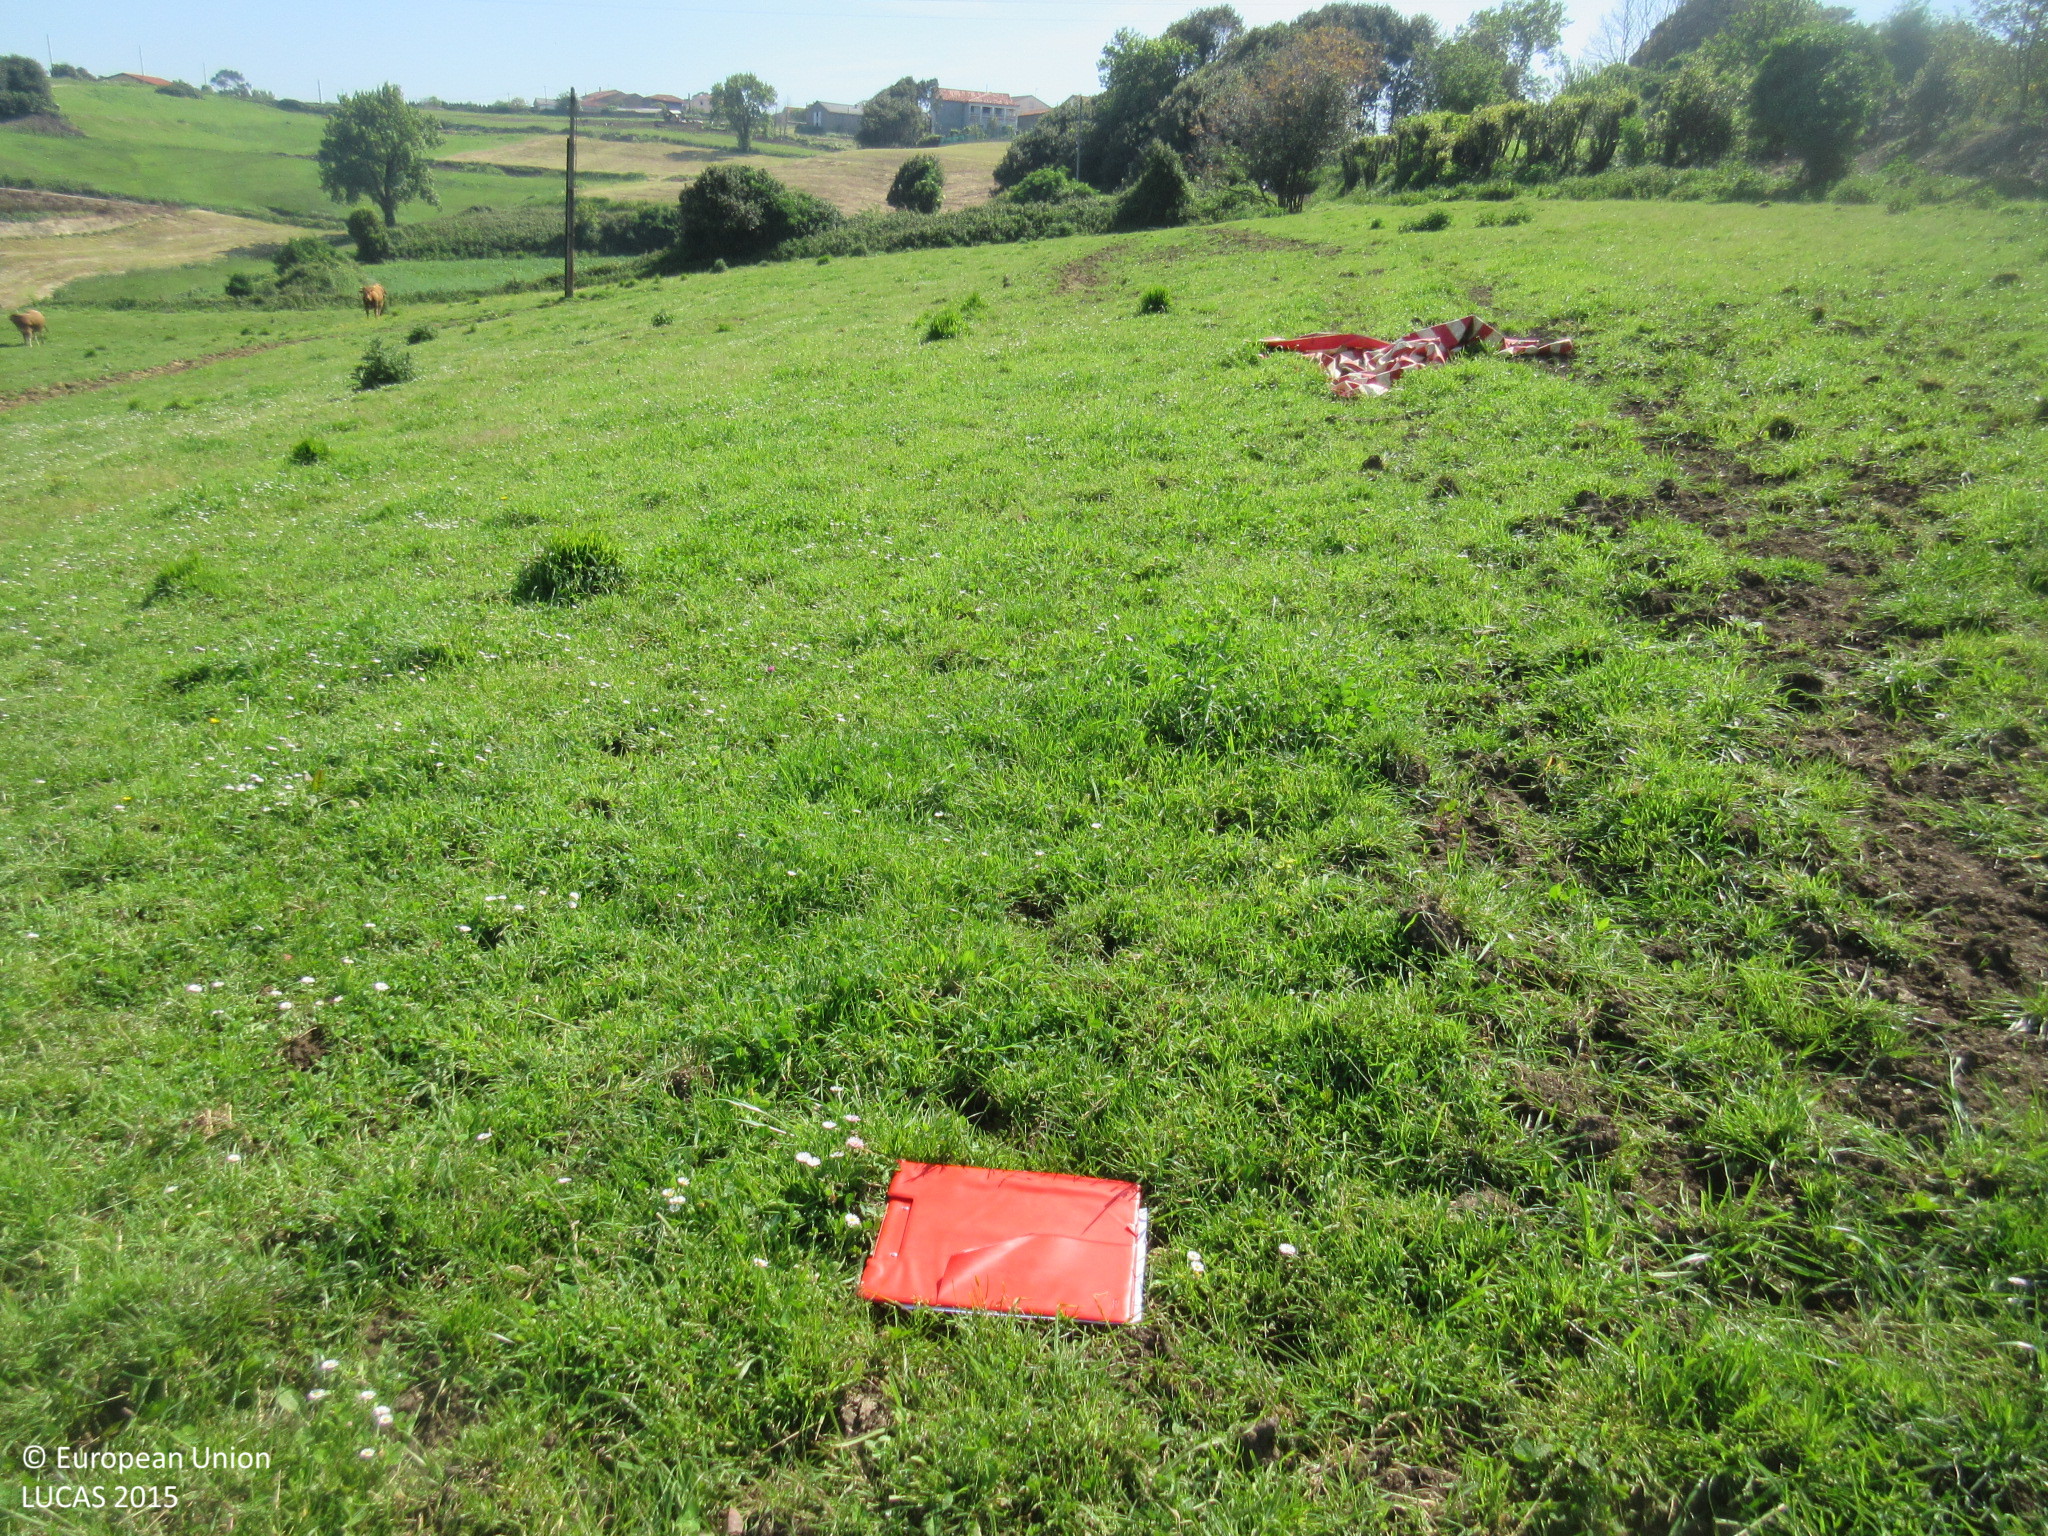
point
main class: Grassland
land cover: Grassland without tree/shrub cover
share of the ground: > 75 %
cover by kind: herbaceous plants 100 %
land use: Agriculture (excluding fallow land and kitchen gardens)
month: May
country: ES
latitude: 43.5911
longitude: -5.9087
